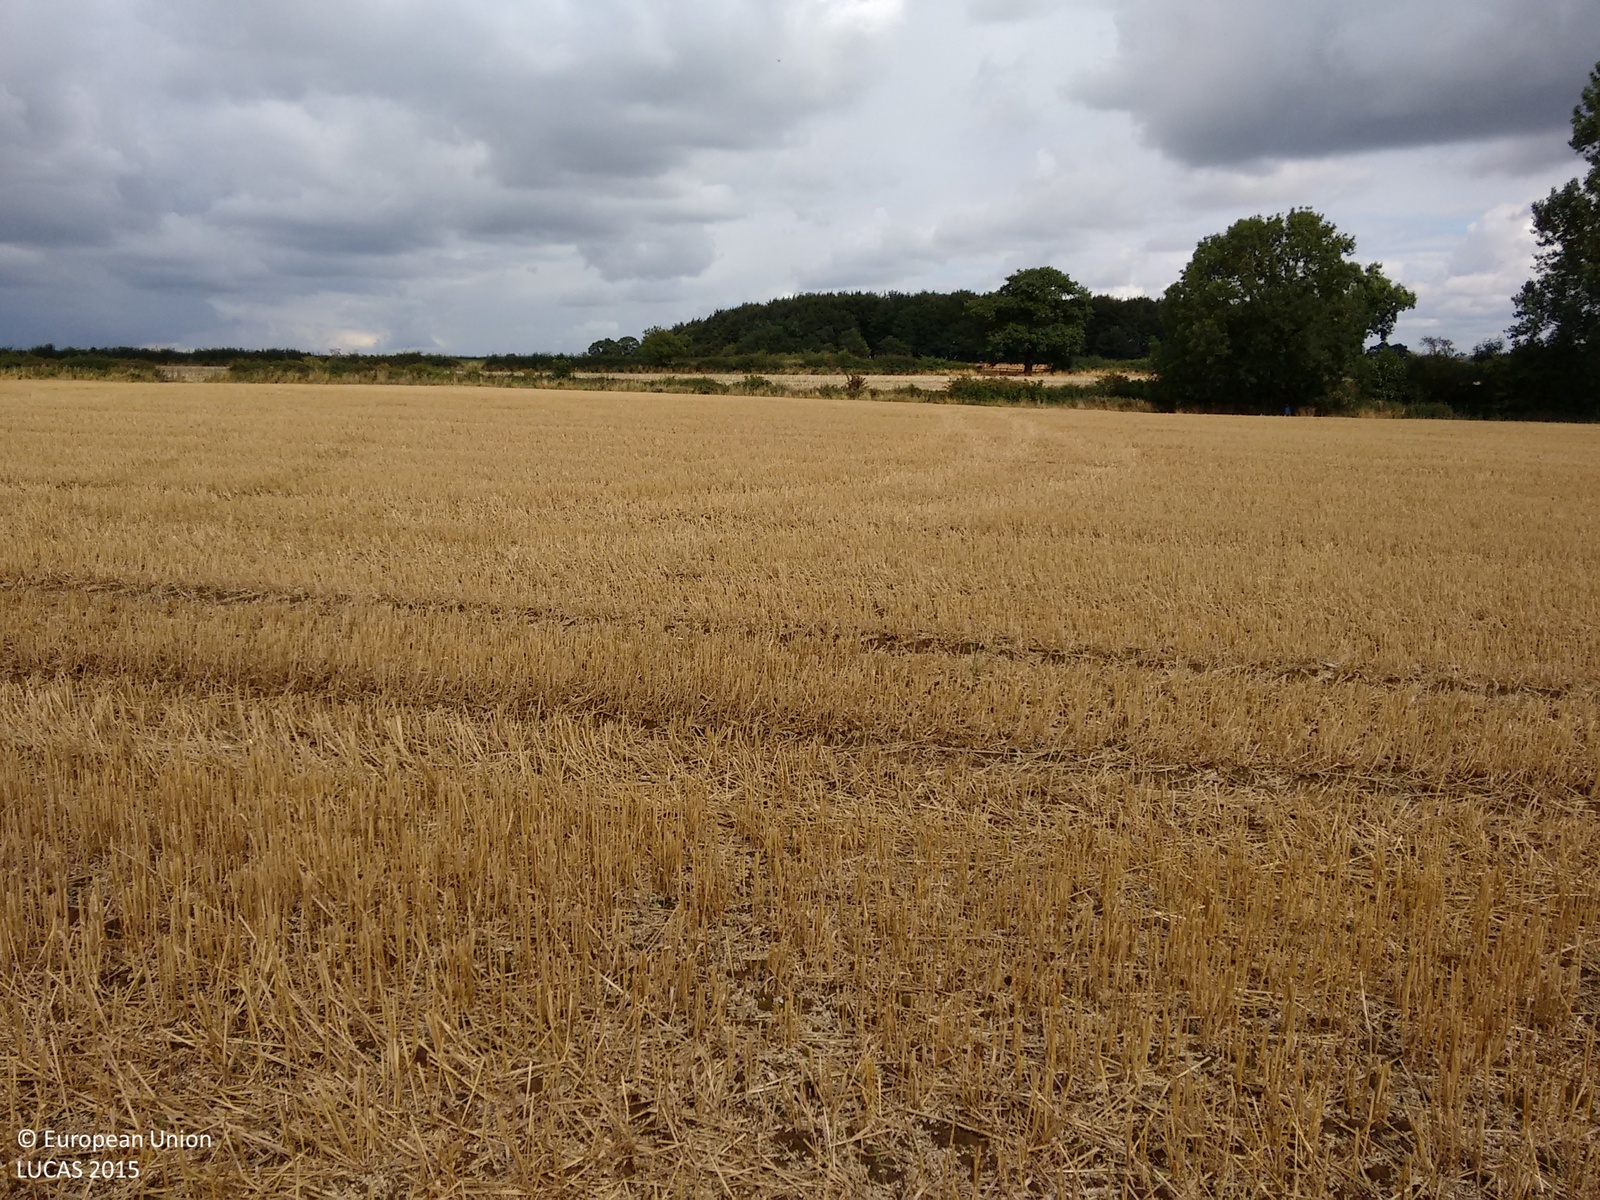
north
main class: Cropland
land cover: Common wheat
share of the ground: > 75 %
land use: Agriculture (excluding fallow land and kitchen gardens)
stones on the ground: < 10 %
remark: Harvested field
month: September
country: GB
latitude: 52.7867
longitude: -1.4224
